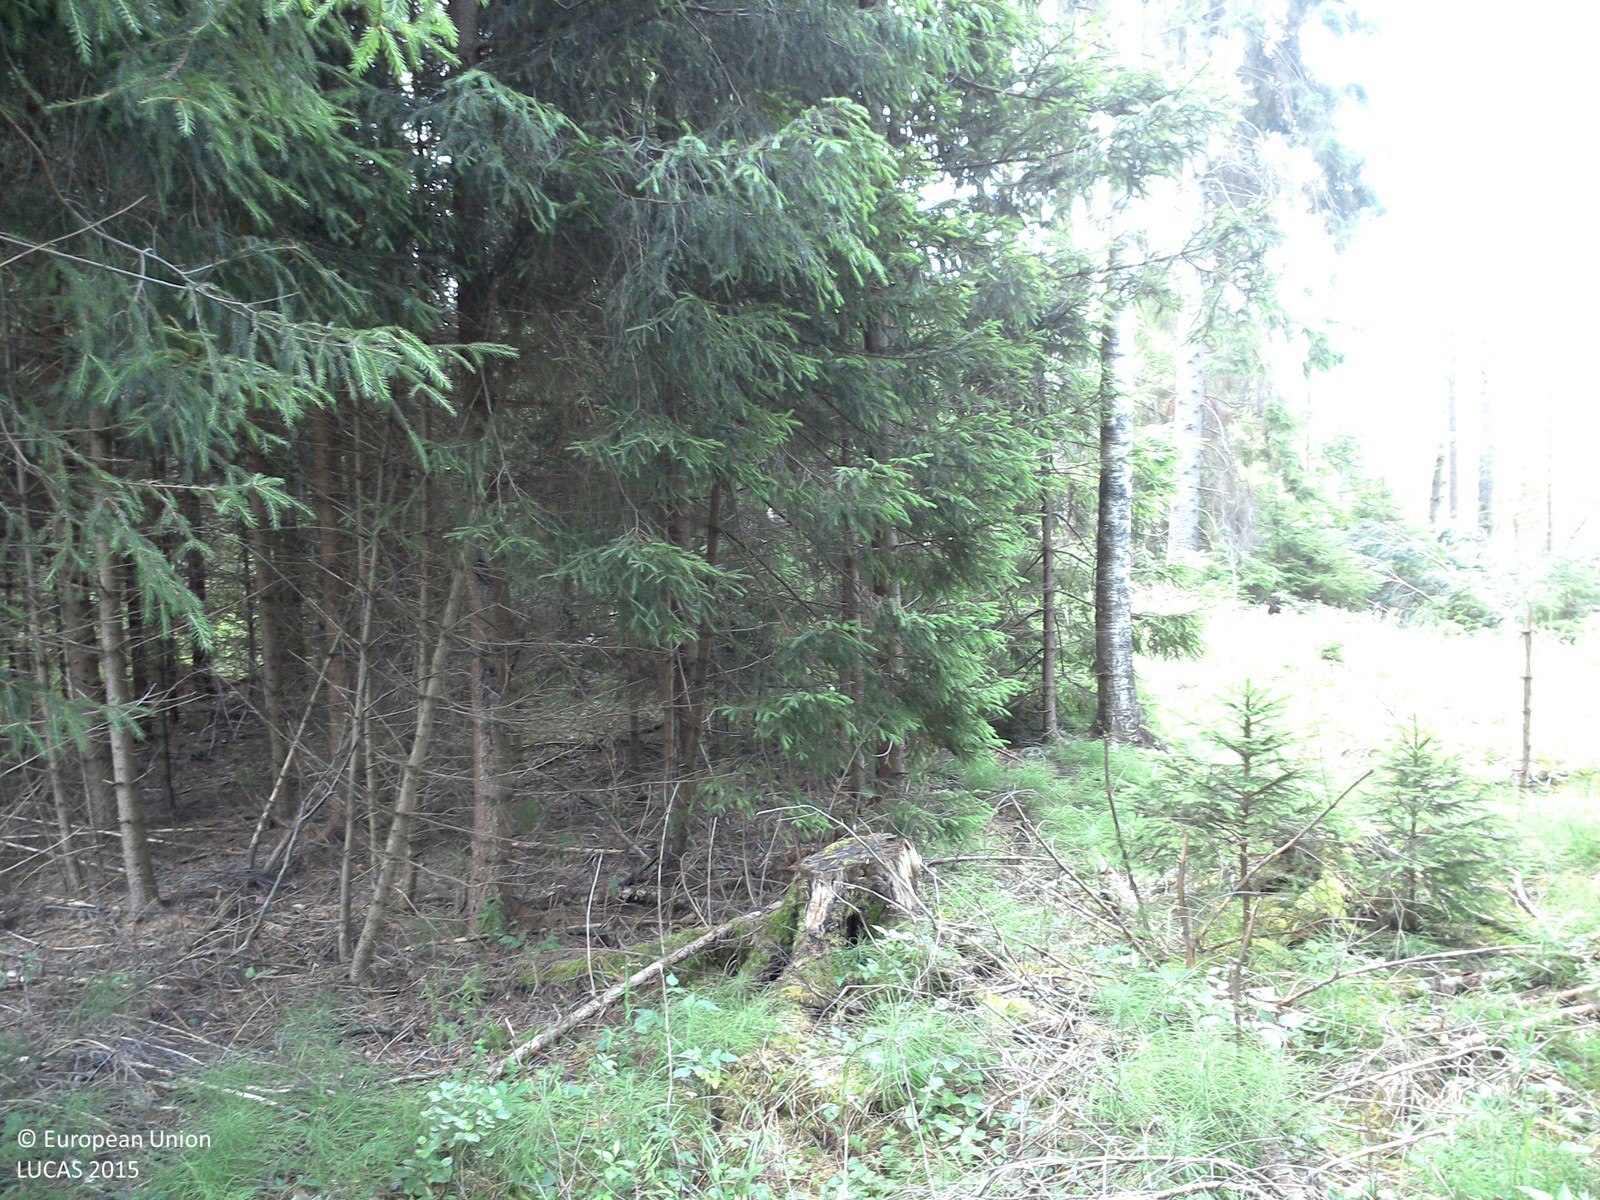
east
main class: Woodland
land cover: Spruce dominated coniferous woodland
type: boreal forest
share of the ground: 50 - 75 %
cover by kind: coniferous forest trees 55 %, herbaceous plants 45 %
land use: Forestry
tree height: > 5 m
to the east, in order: Spruce dominated coniferous woodland; Pine dominated coniferous woodland; Inland marshes; Broadleaved woodland; Pine dominated coniferous woodland; Electric lines; Ditches and canals; Grass margins; Paved roads, cycling and walking lanes; Grass margins; Ditches and canals; Pine dominated coniferous woodland
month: July
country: SE
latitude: 58.0621
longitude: 14.7911
